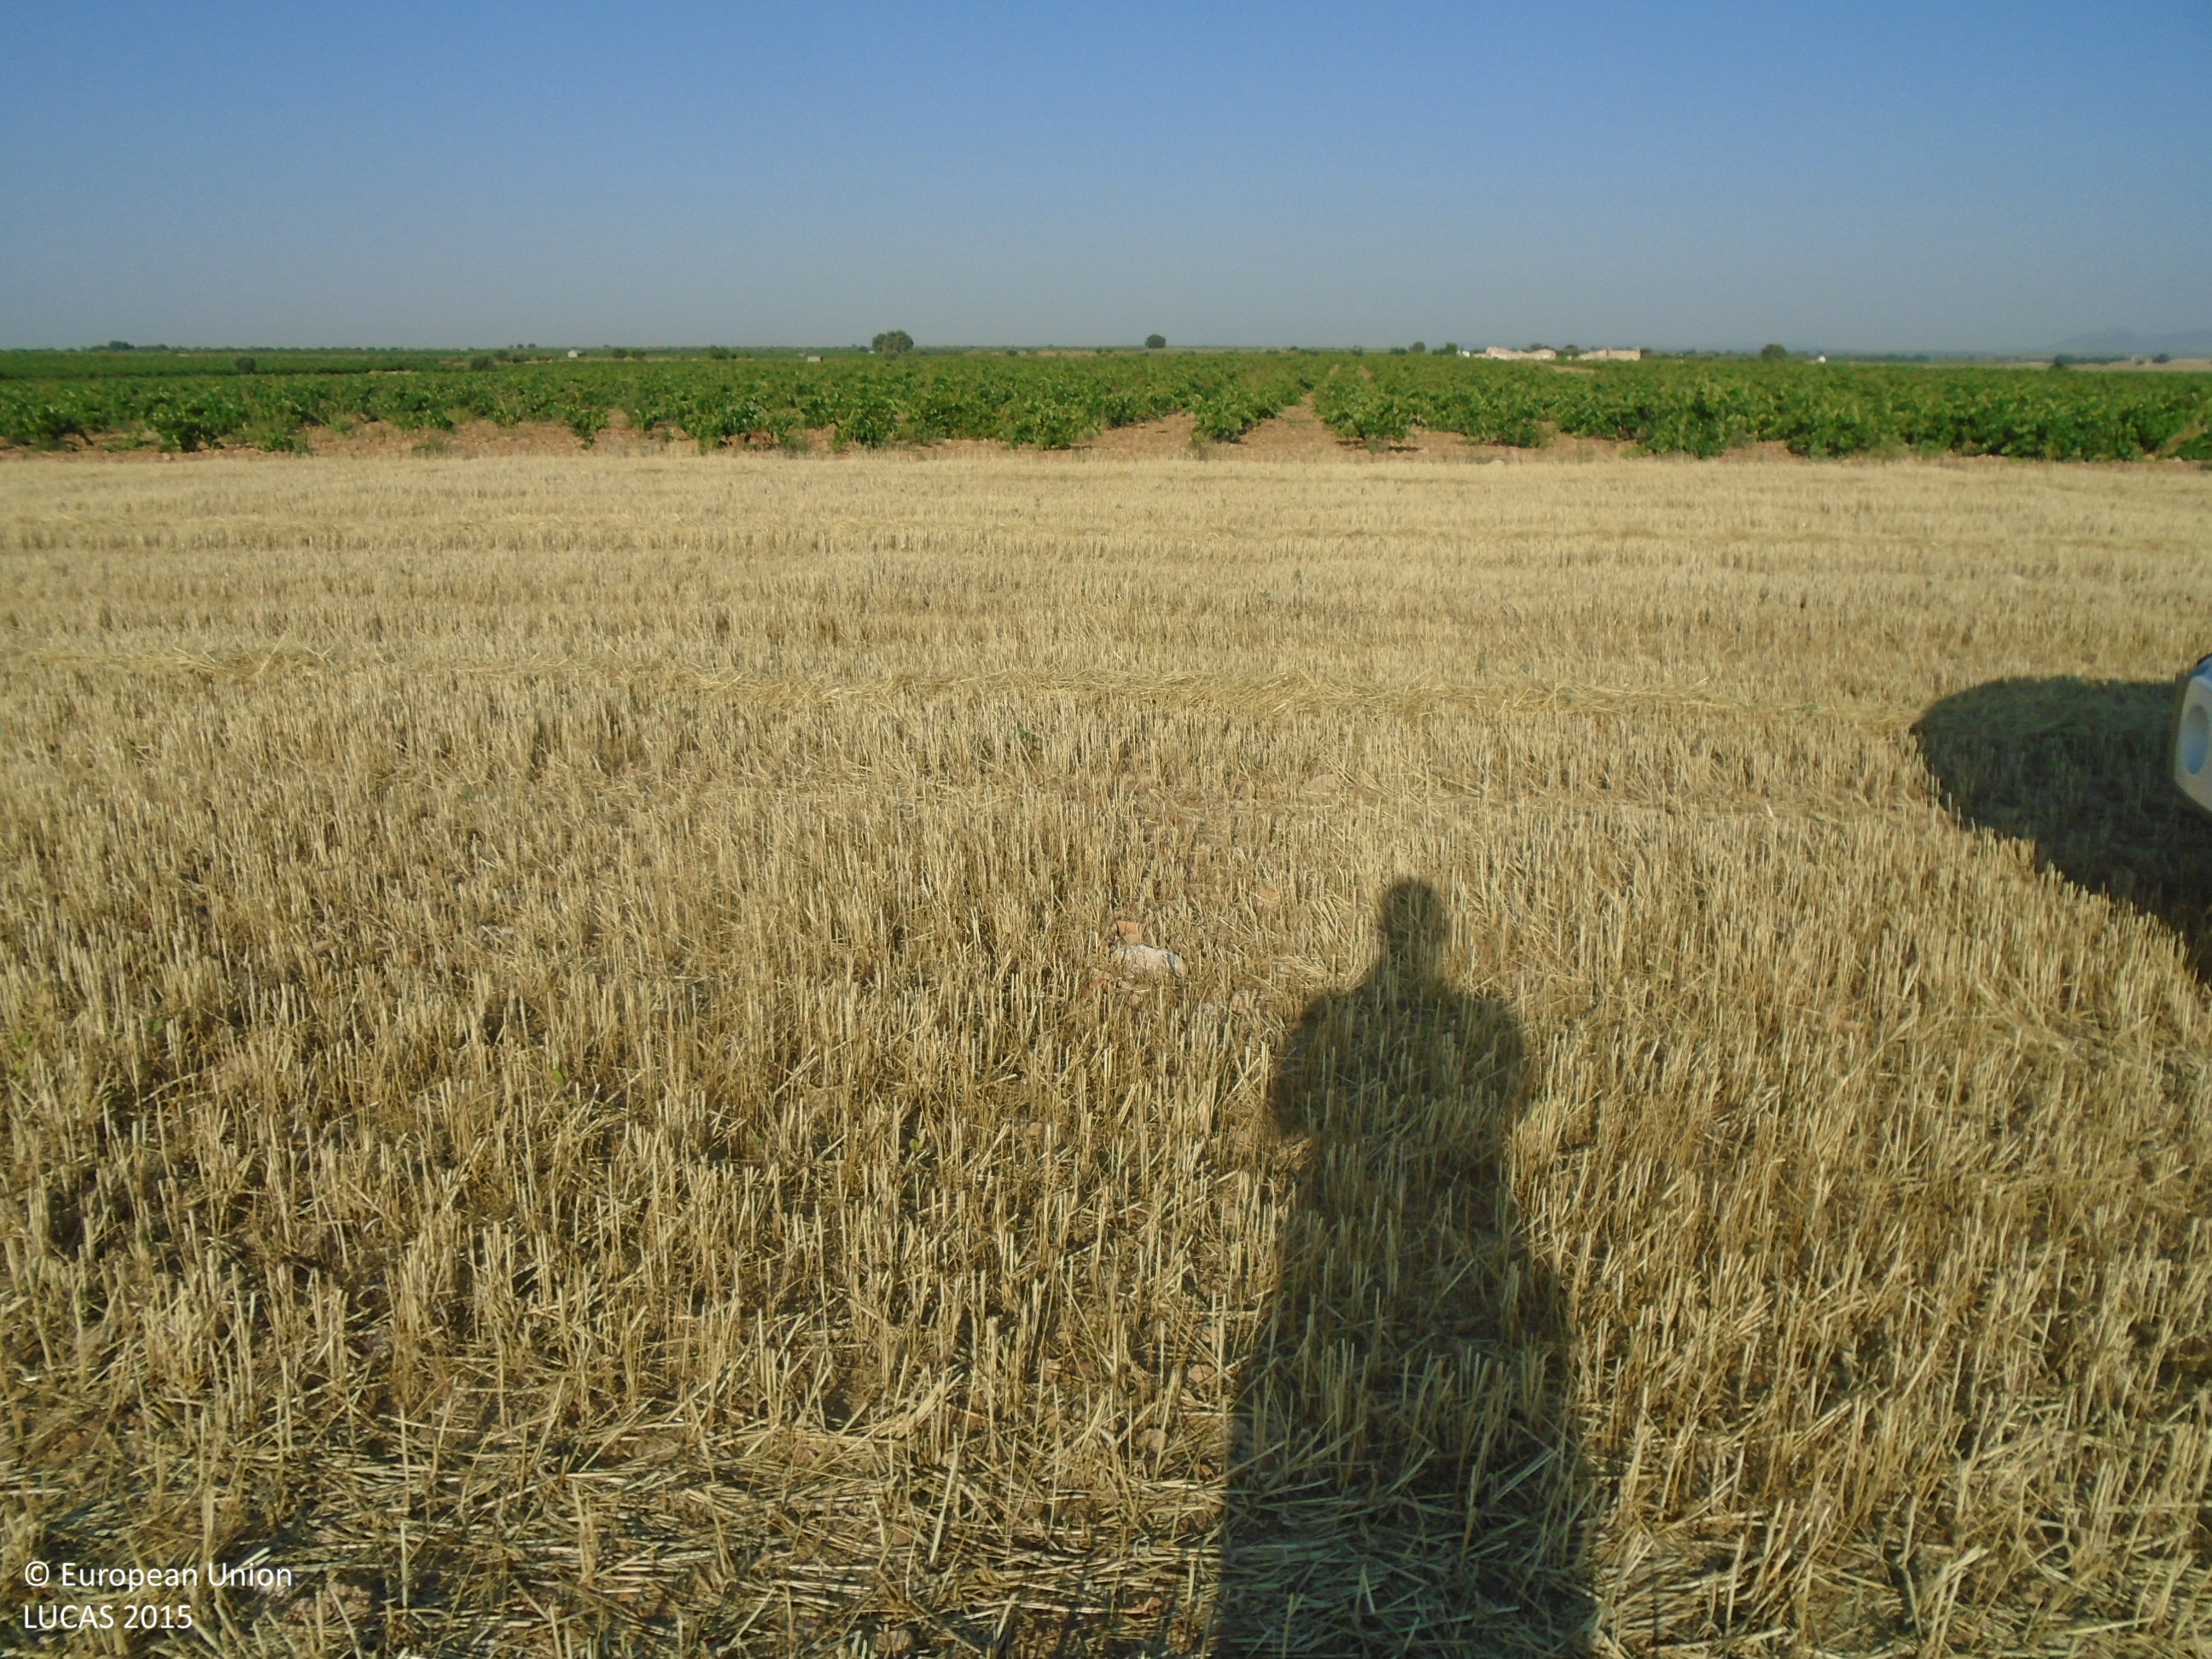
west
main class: Cropland
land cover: Barley
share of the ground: > 75 %
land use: Agriculture (excluding fallow land and kitchen gardens)
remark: Harvested field
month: June
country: ES
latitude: 39.1694
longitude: -3.5959
